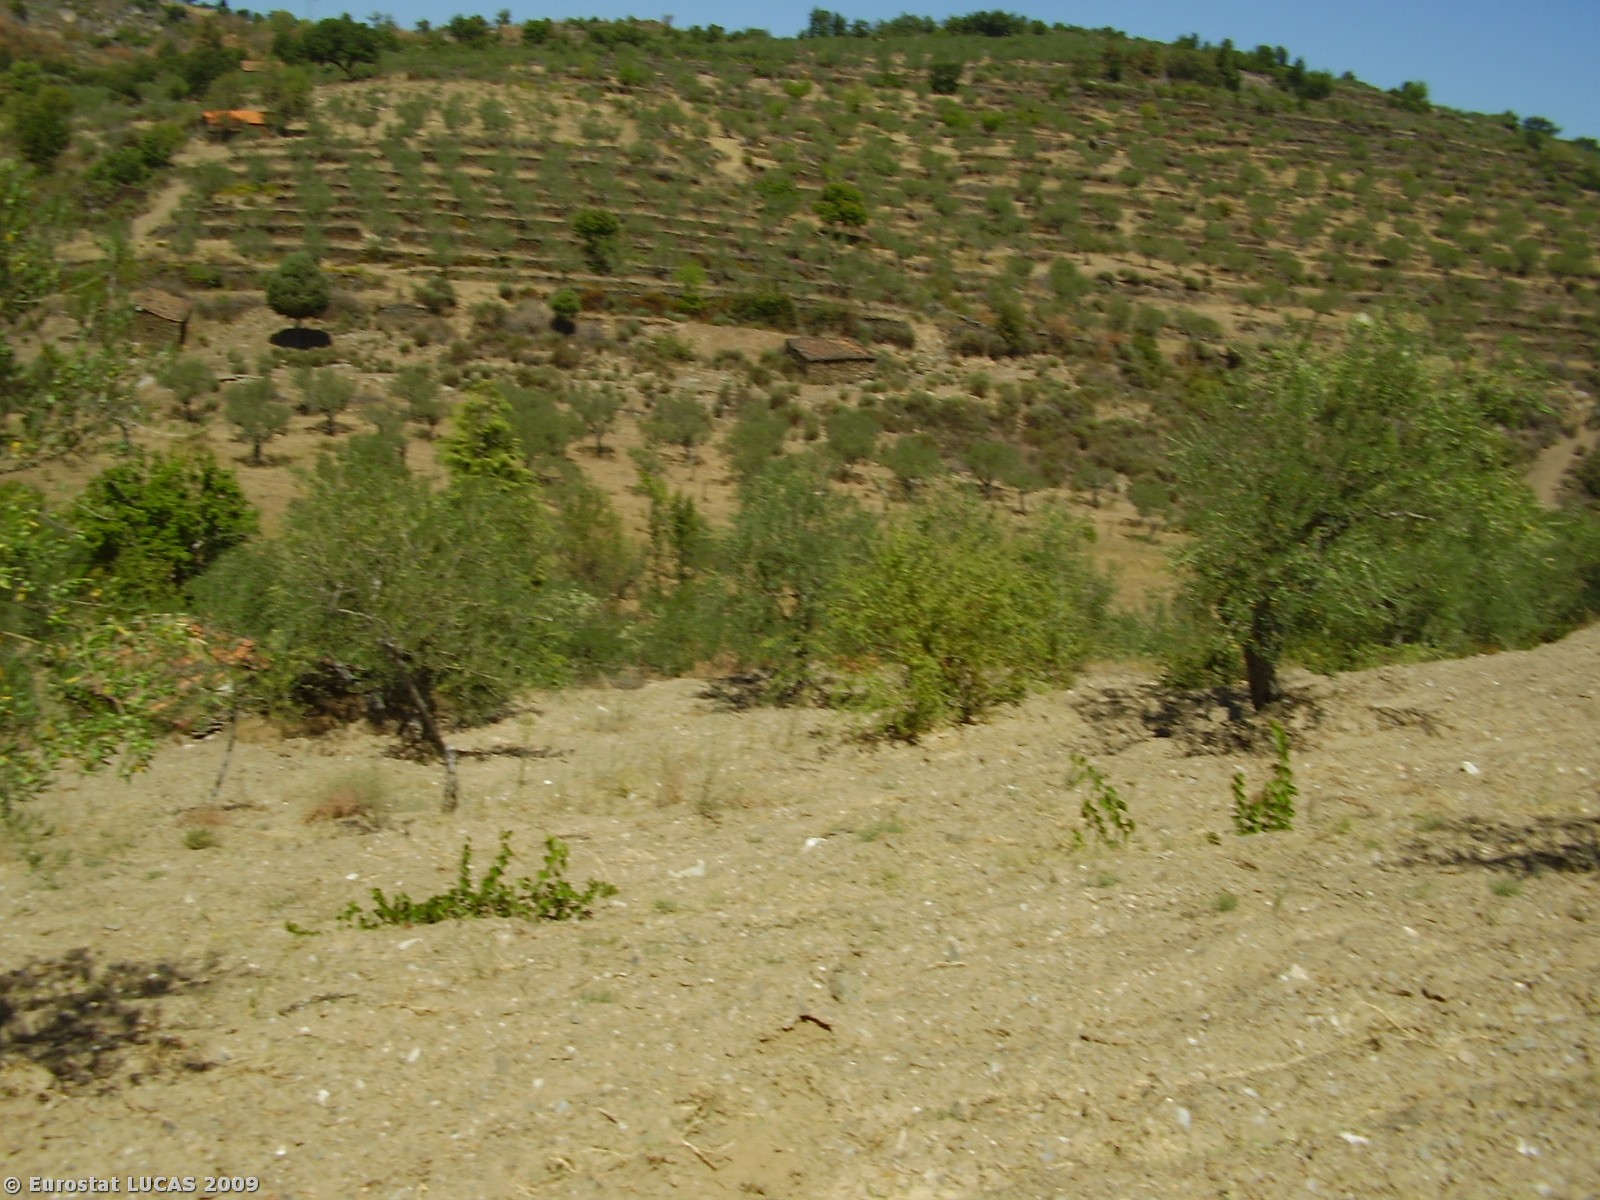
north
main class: Cropland
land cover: Olive groves
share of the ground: 50 - 75 %
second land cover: Bare land
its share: > 75 %
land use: Agriculture (excluding fallow land and kitchen gardens)
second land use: Fallow land
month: August
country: PT
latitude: 41.1985
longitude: -6.7137
